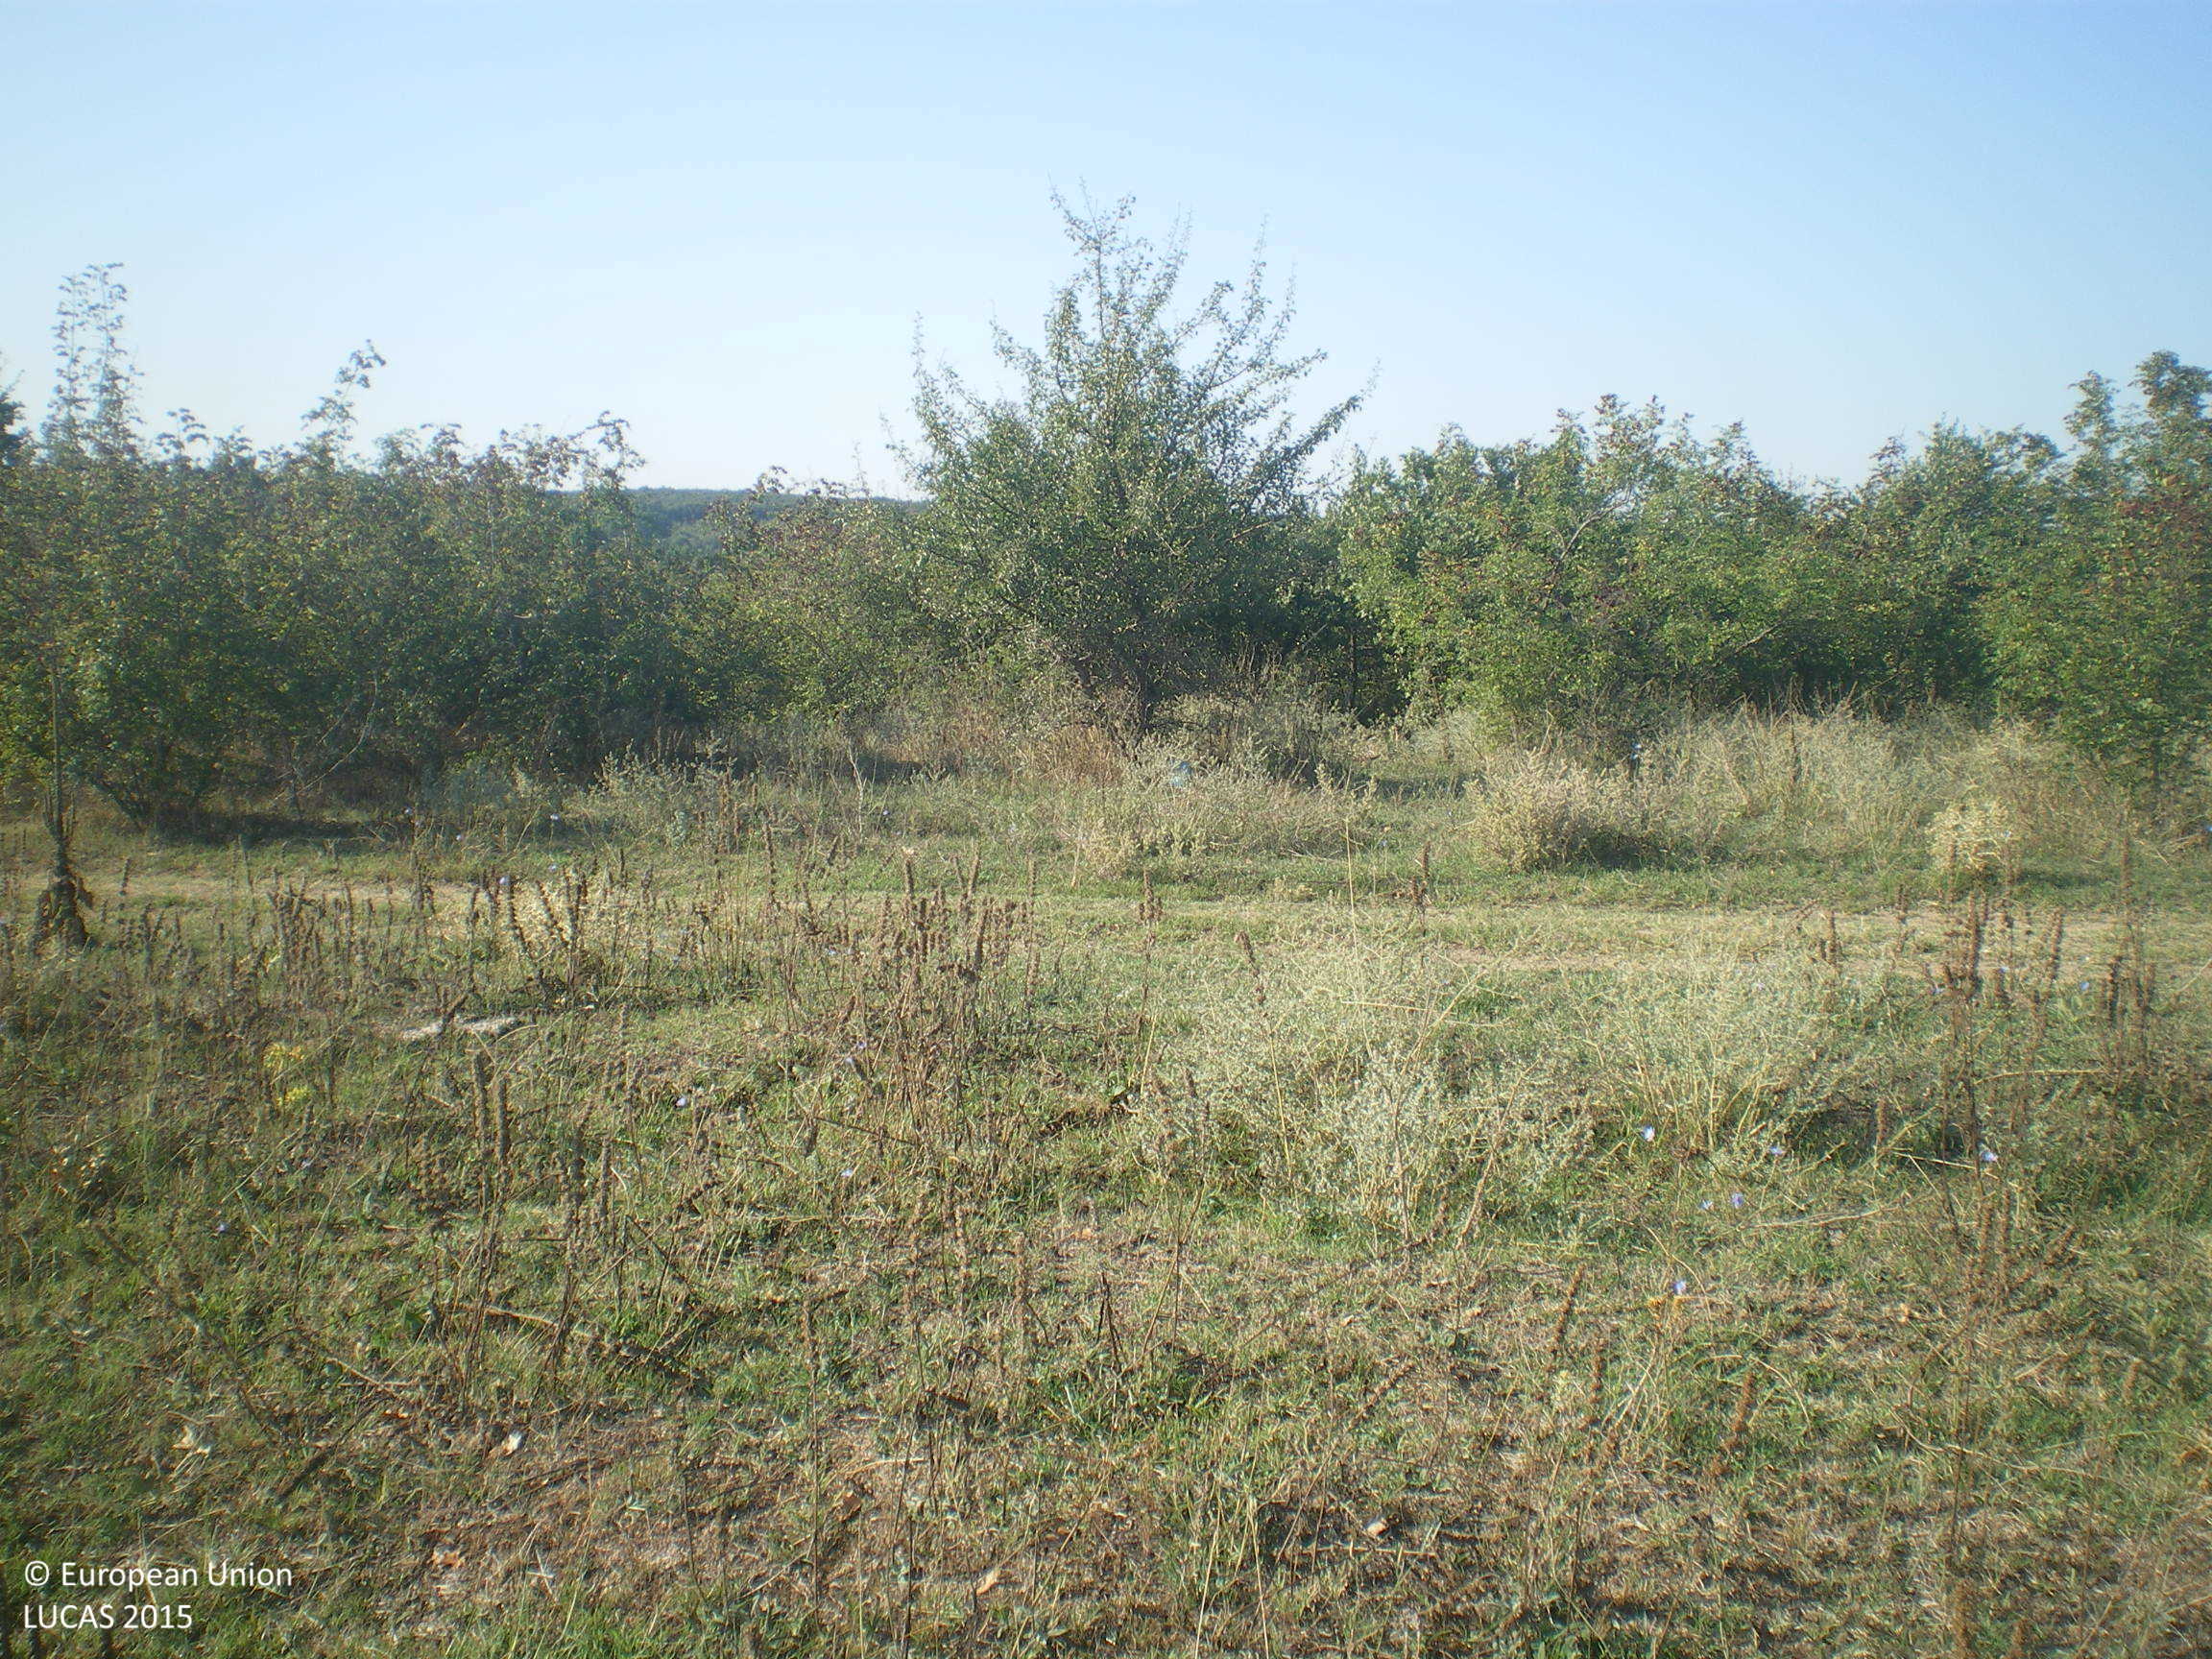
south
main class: Grassland
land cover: Grassland with sparse tree/shrub cover
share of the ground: > 75 %
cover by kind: herbaceous plants 85 %, shrubs 10 %, broadleaved forest trees 5 %
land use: Agriculture (excluding fallow land and kitchen gardens)
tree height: > 5 m
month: August
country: BG
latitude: 42.0619
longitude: 25.9409
